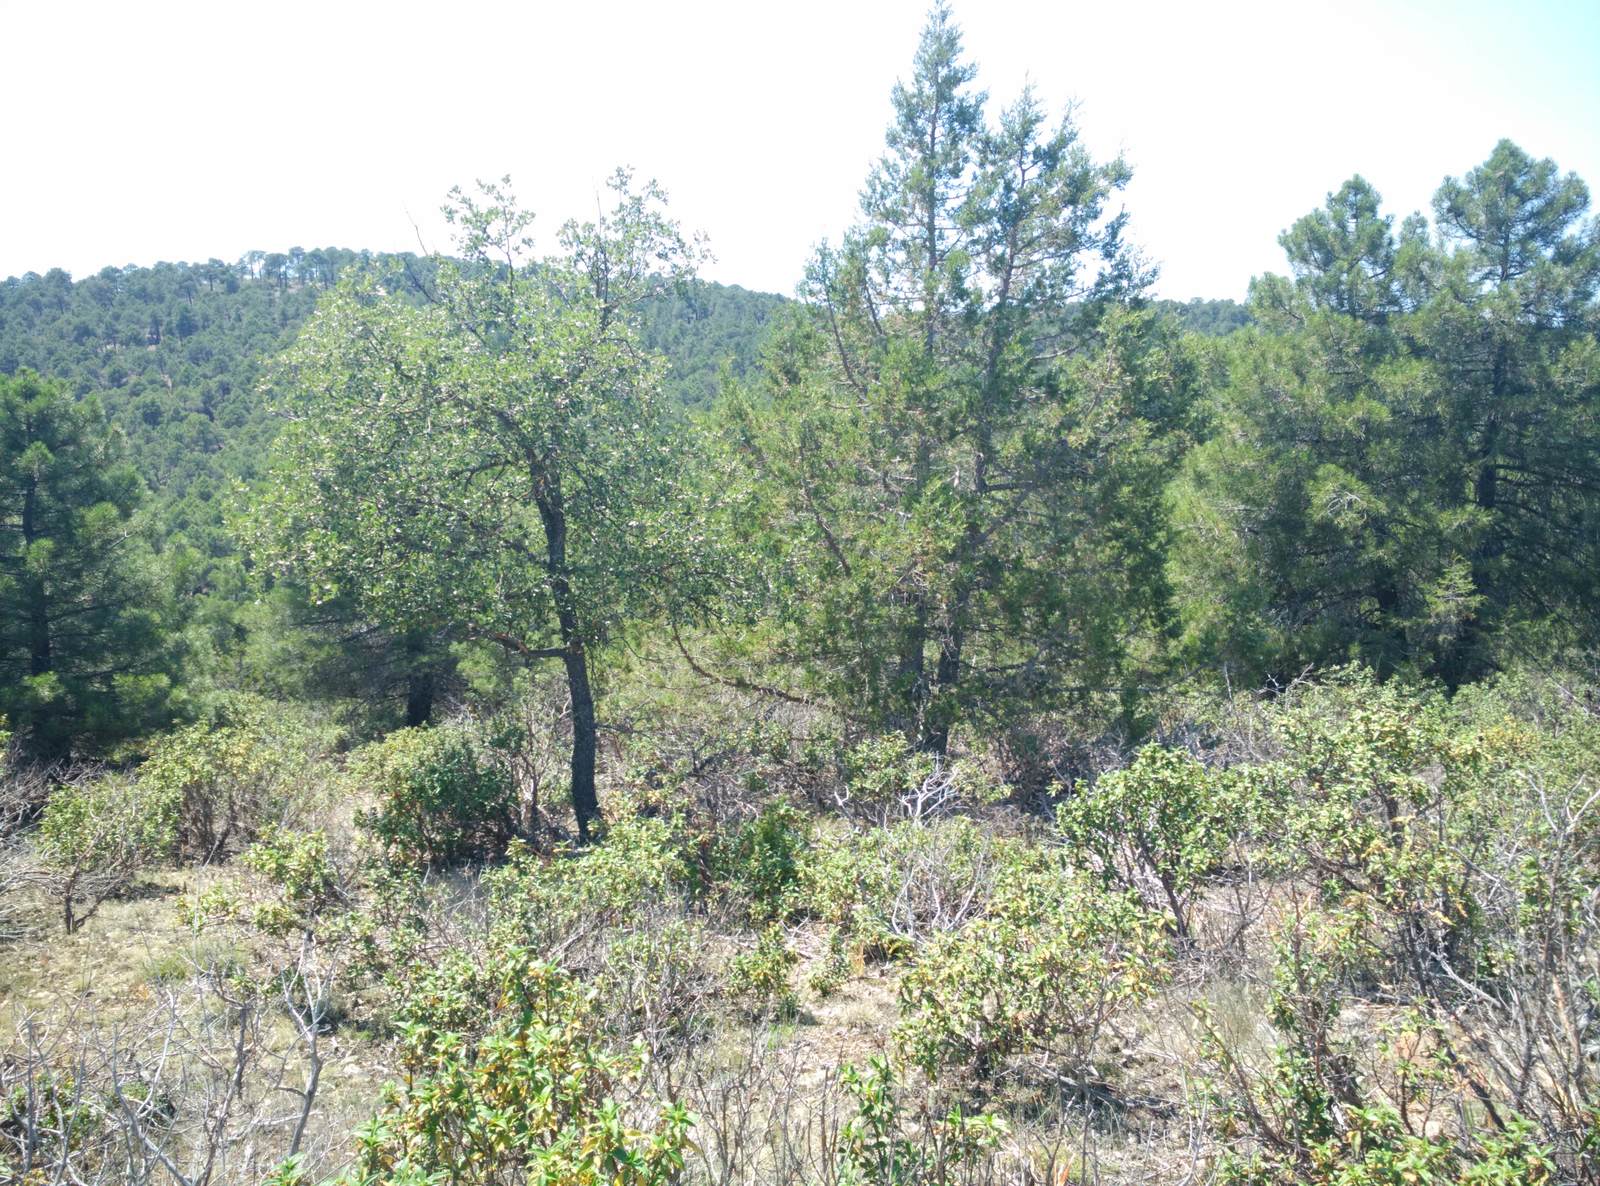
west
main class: Woodland
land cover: Pine dominated coniferous woodland
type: coniferous forest of the mediterranean region
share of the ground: 25 - 50 %
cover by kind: shrubs 60 %, coniferous forest trees 35 %, unconsolidated bare surface 5 %
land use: Semi-natural and natural areas not in use
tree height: > 5 m
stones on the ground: < 10 %
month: June
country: ES
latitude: 40.8113
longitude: -1.9603
